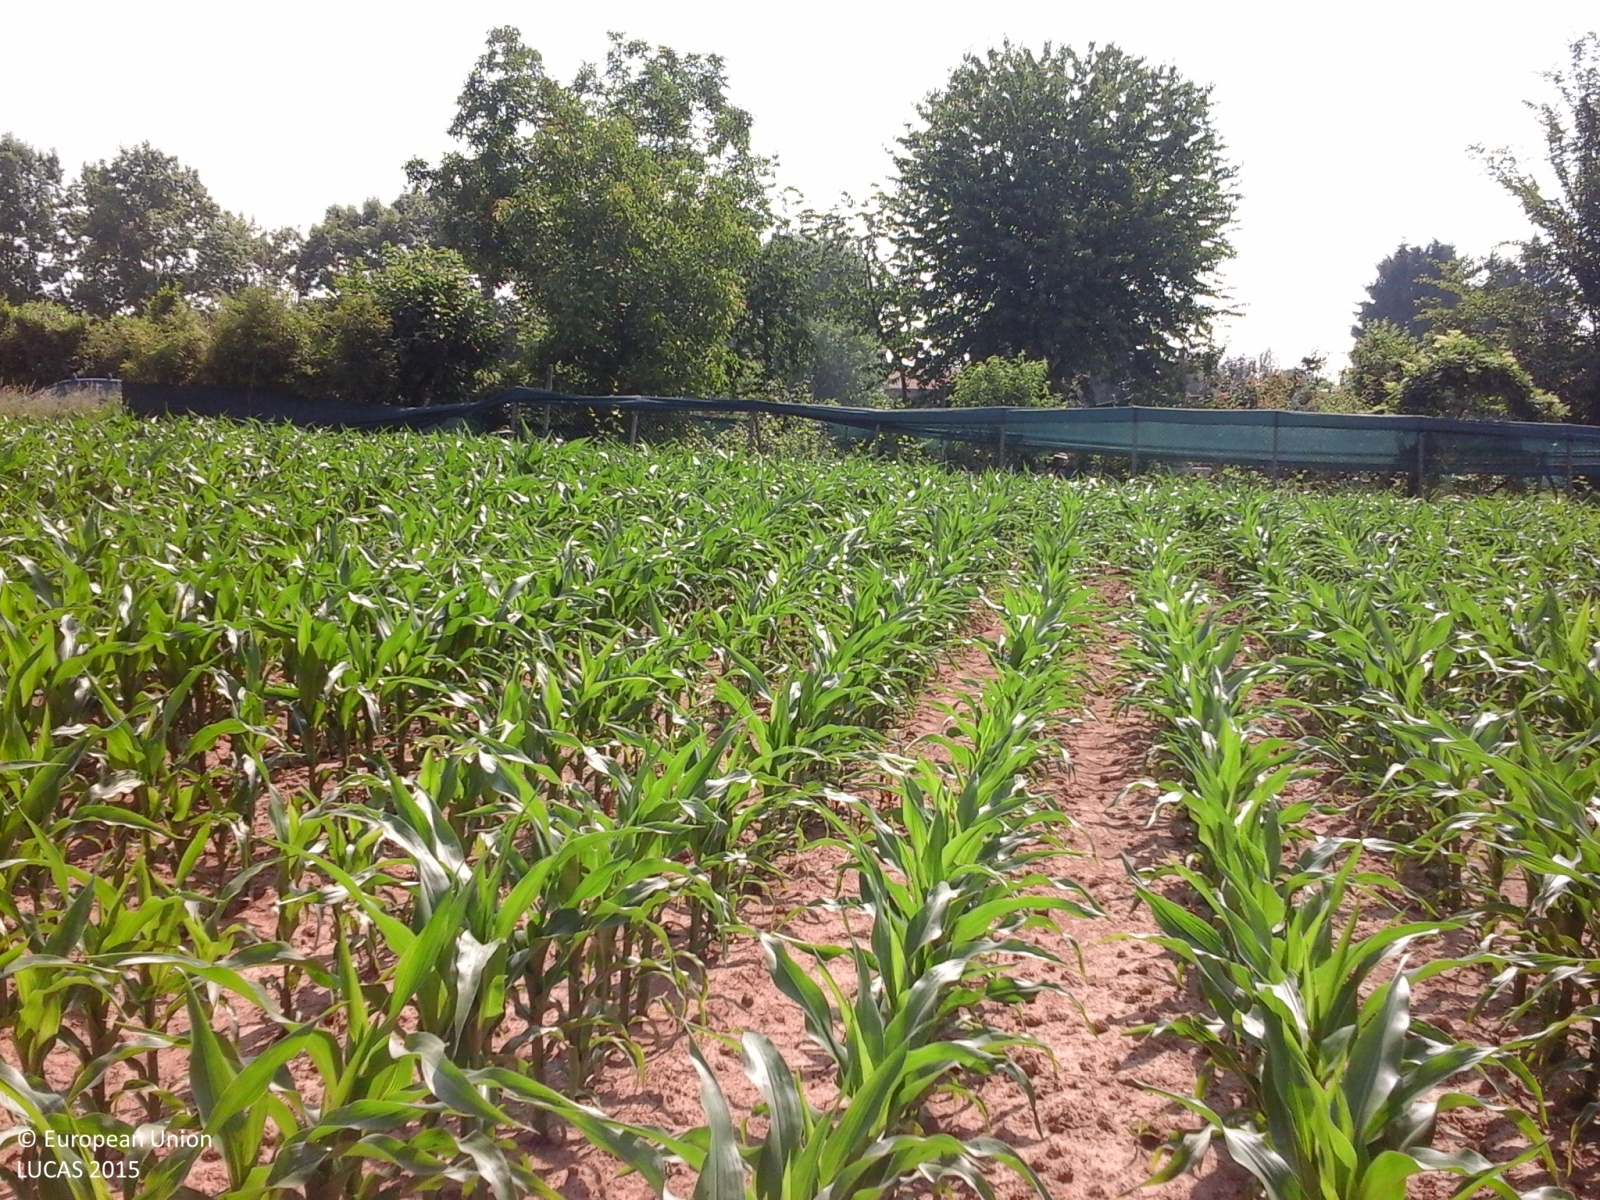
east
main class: Cropland
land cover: Maize
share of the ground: > 75 %
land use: Agriculture (excluding fallow land and kitchen gardens)
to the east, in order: Maize; Artificial constructions in urban areas; Grassland without tree/shrub cover; Artificial constructions in urban areas; Grassland without tree/shrub cover
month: June
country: IT
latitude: 44.9763
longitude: 7.7849
